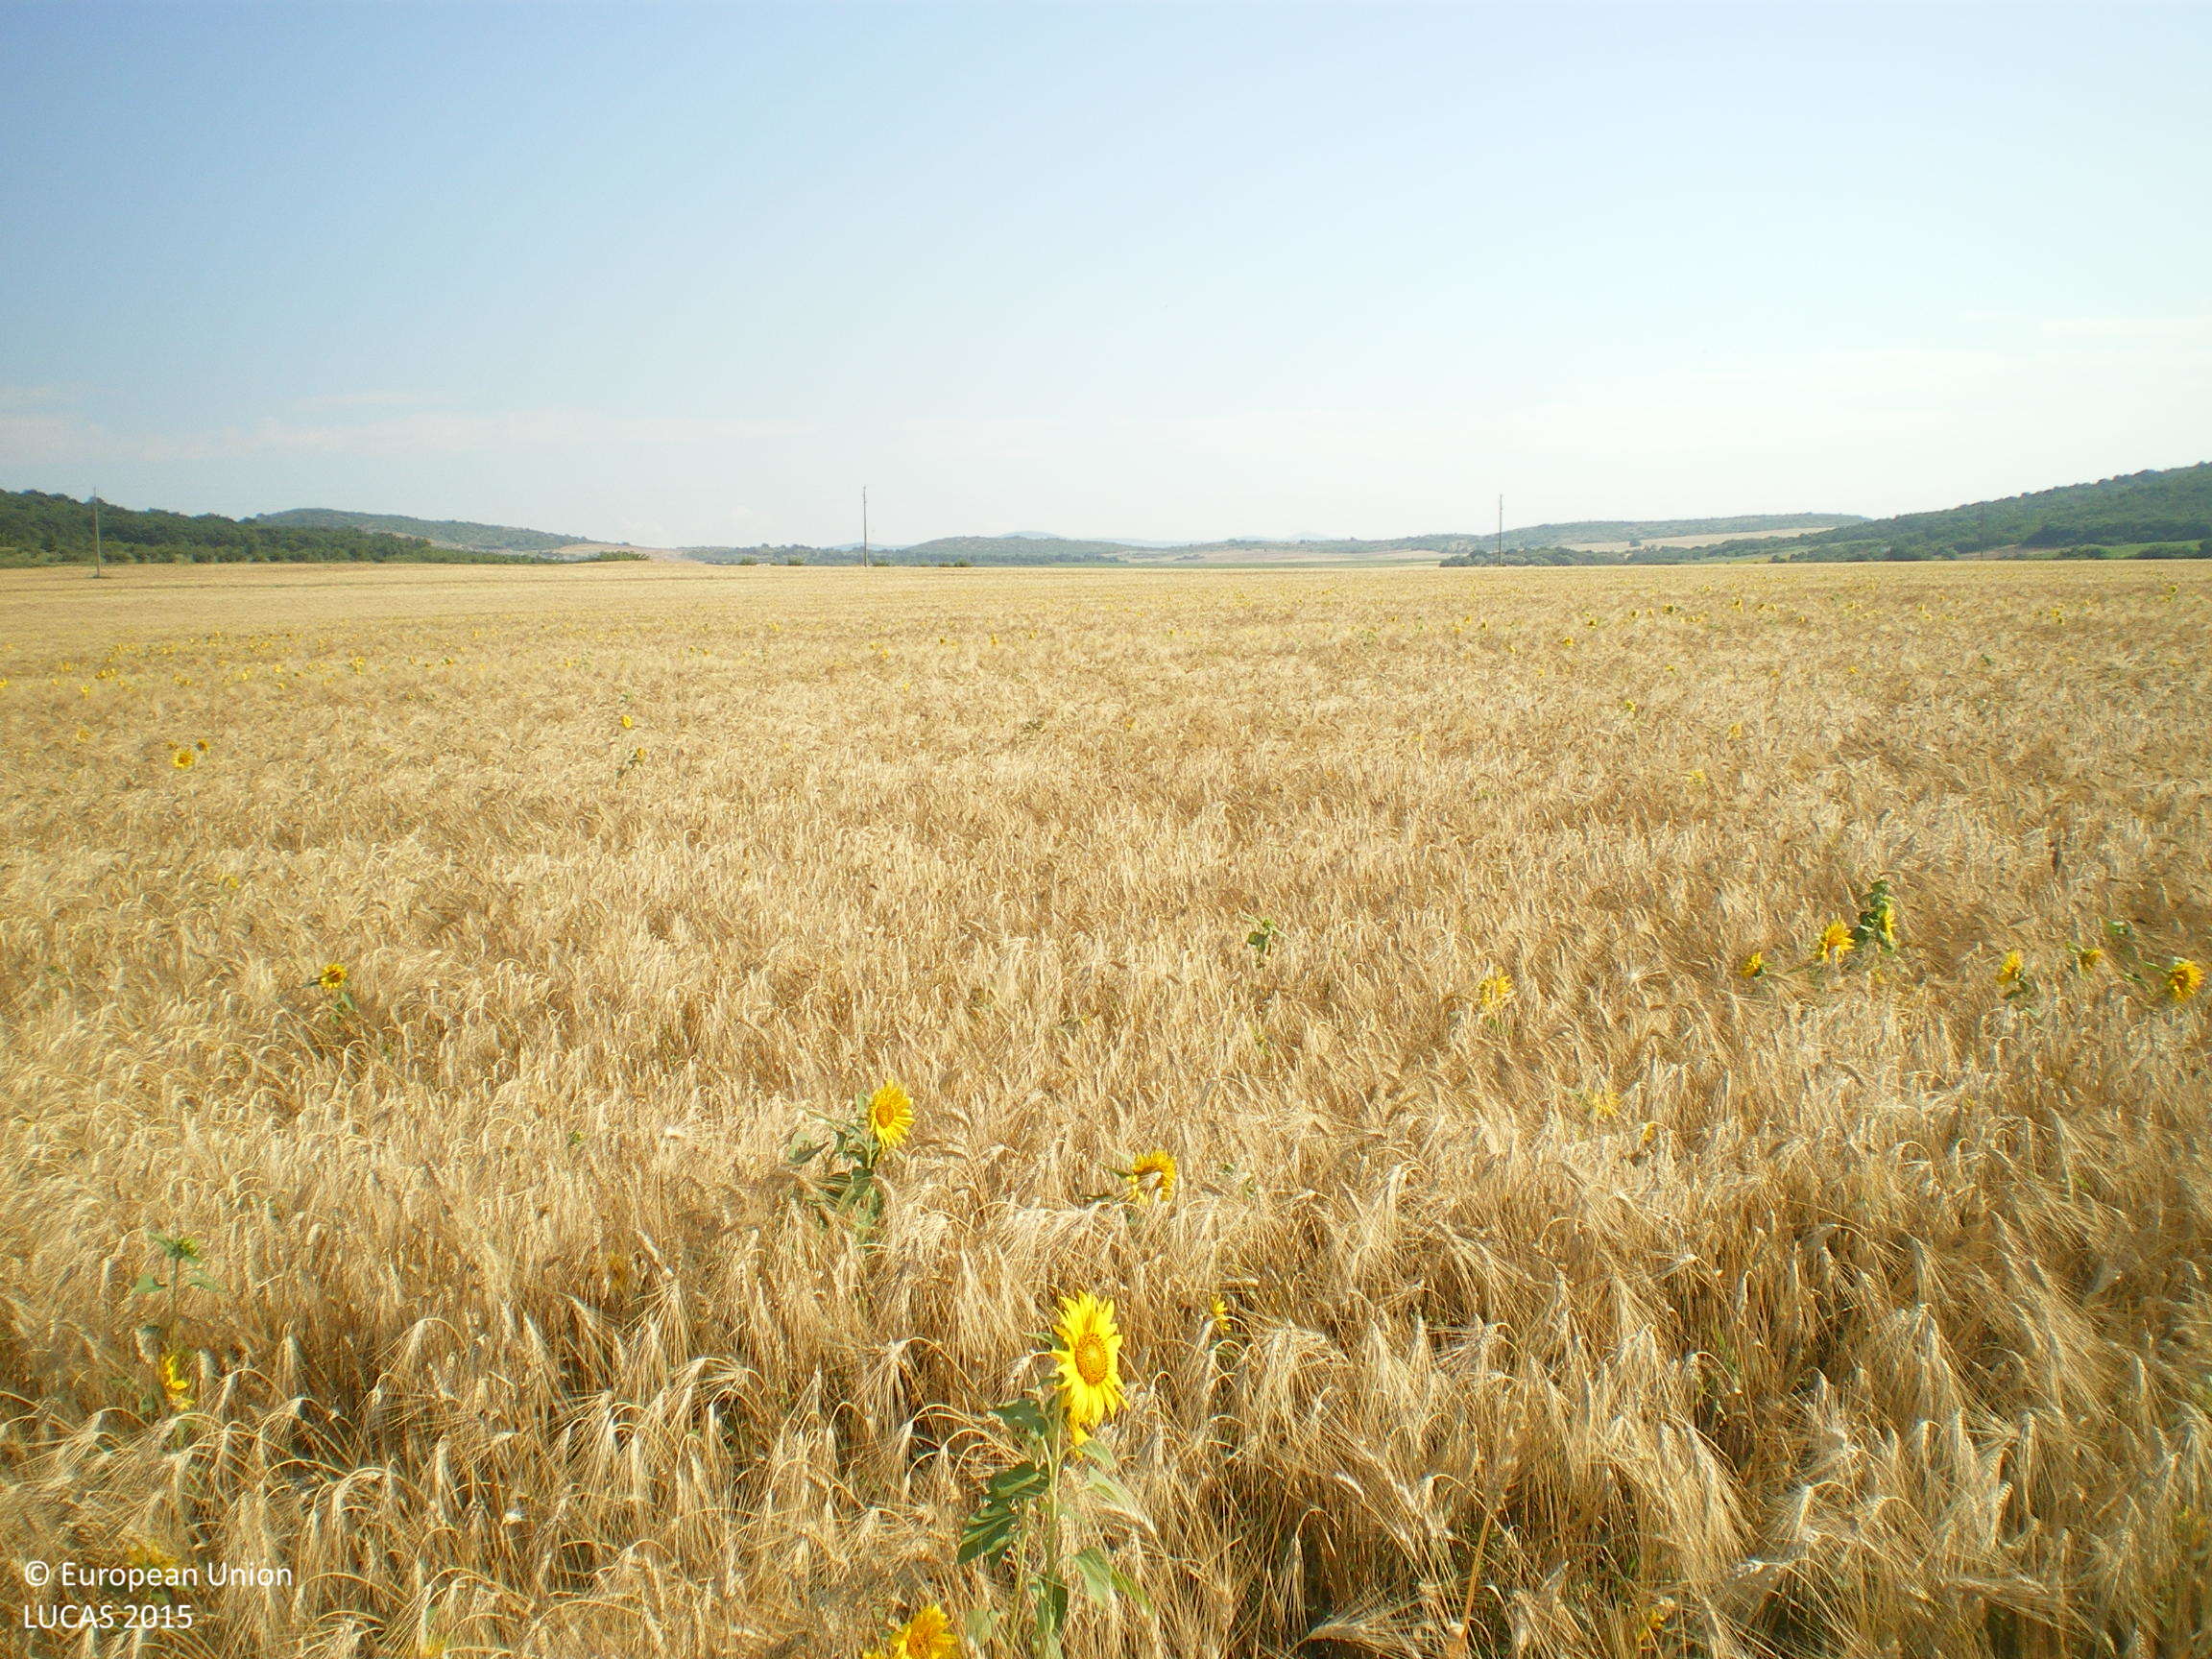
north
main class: Cropland
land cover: Barley
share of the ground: > 75 %
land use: Agriculture (excluding fallow land and kitchen gardens)
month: July
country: BG
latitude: 42.3270
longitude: 25.5412
